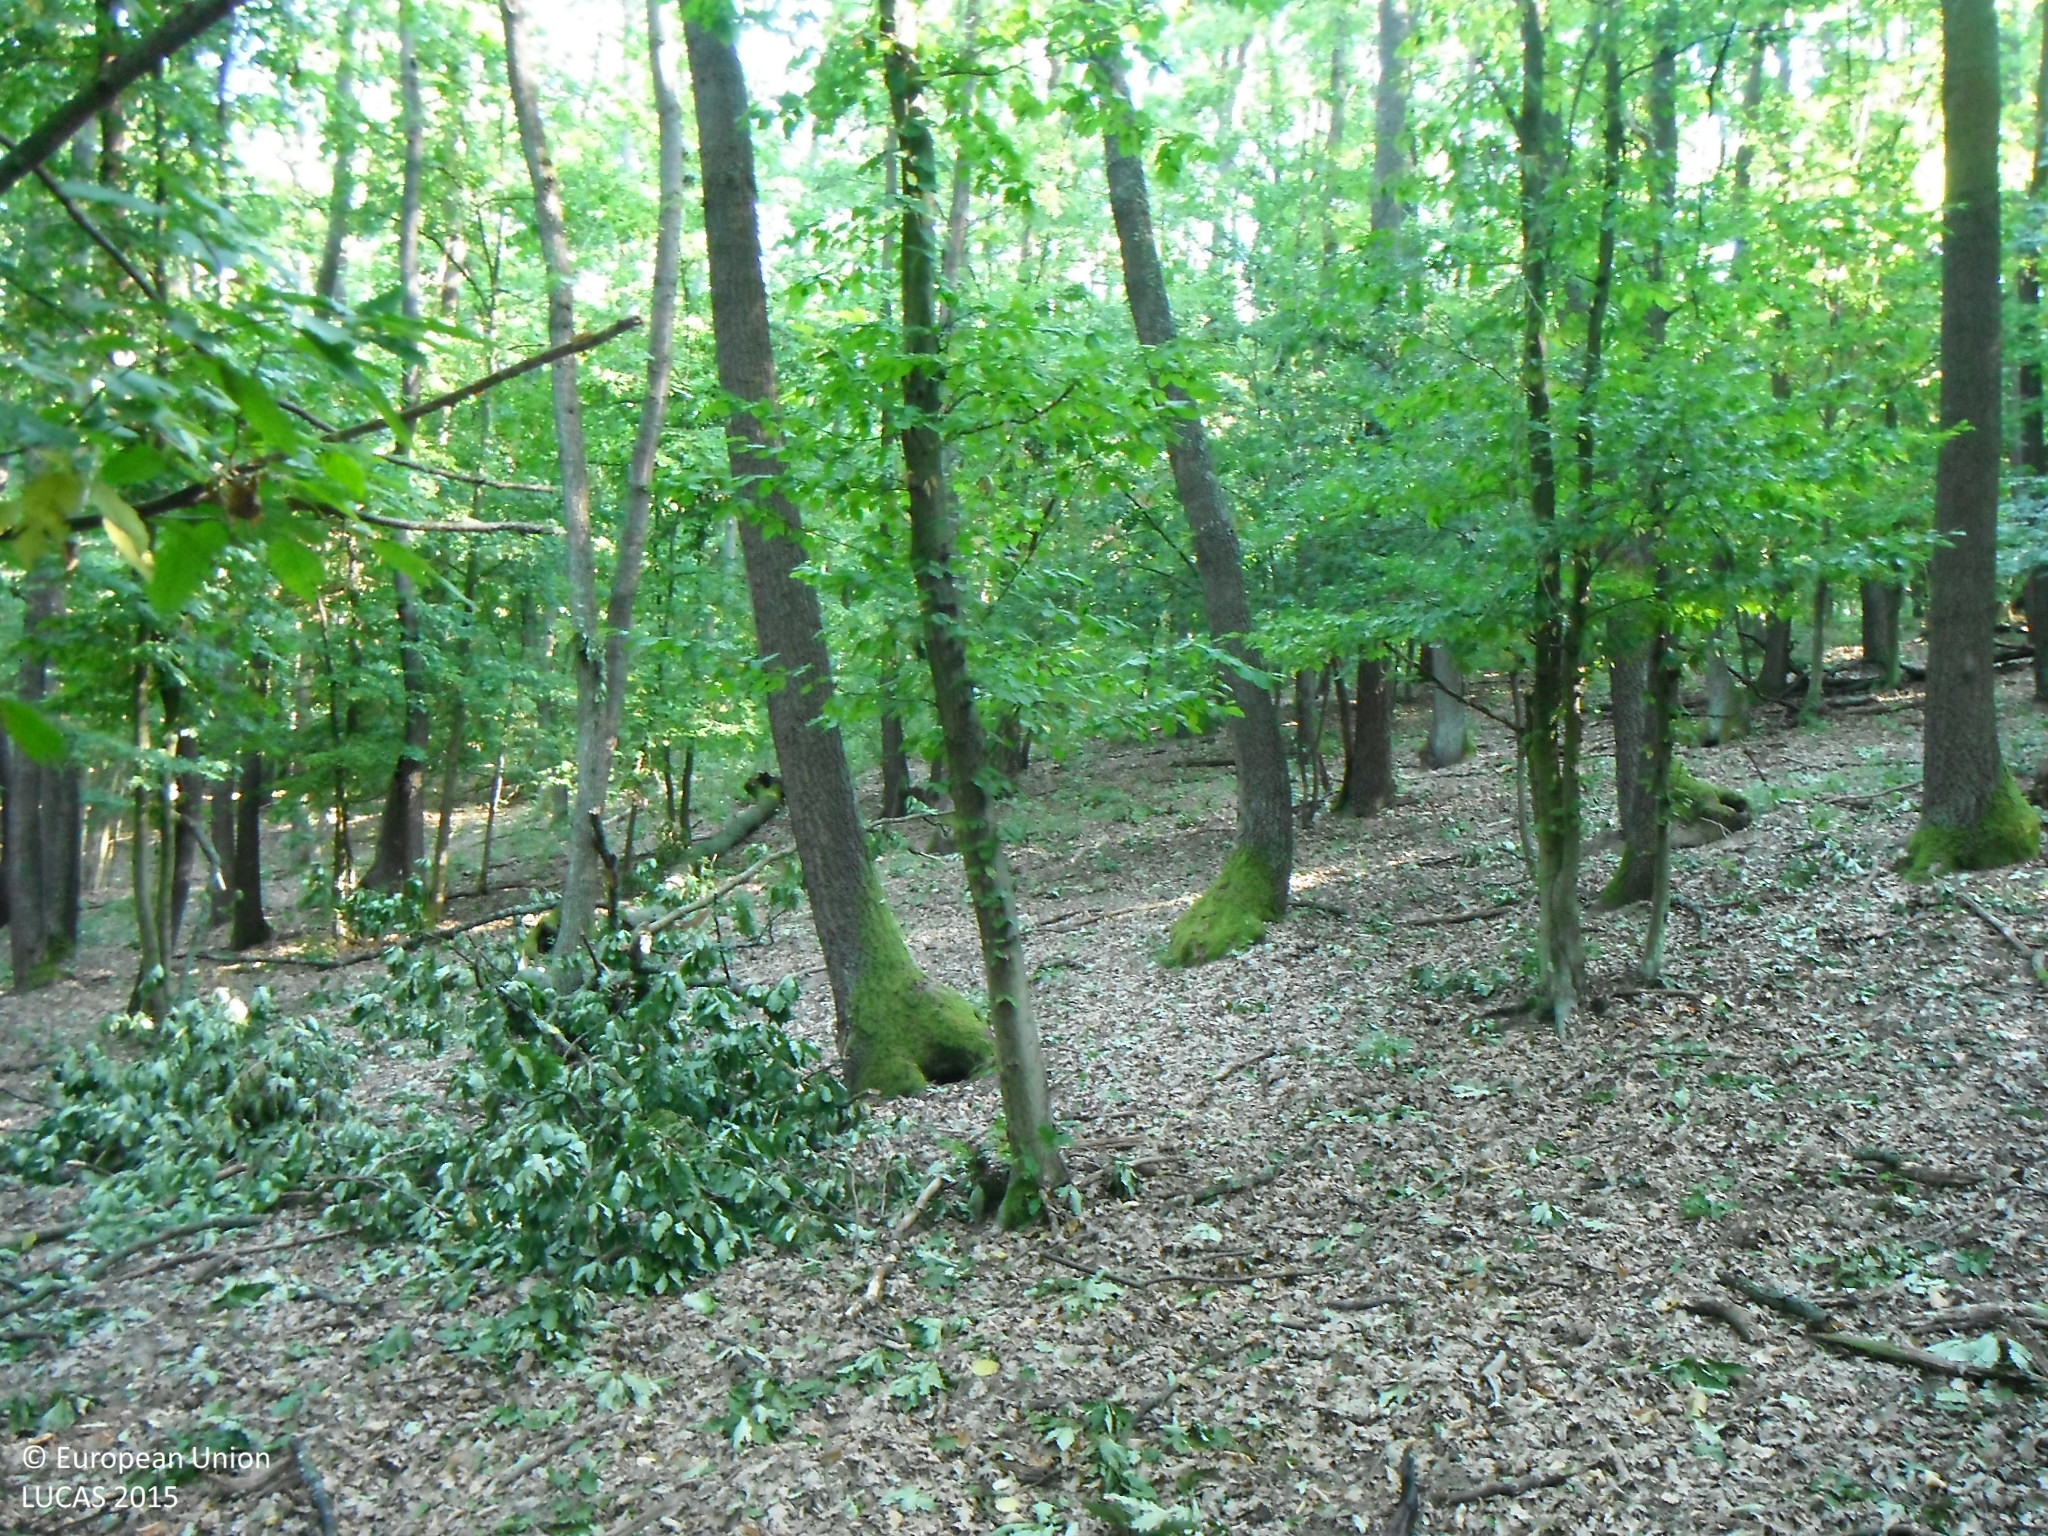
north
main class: Woodland
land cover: Broadleaved woodland
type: mesophytic deciduous forest
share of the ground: > 75 %
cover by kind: broadleaved forest trees 100 %
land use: Forestry
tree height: > 5 m
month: July
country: SK
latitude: 48.2790
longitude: 19.5517
